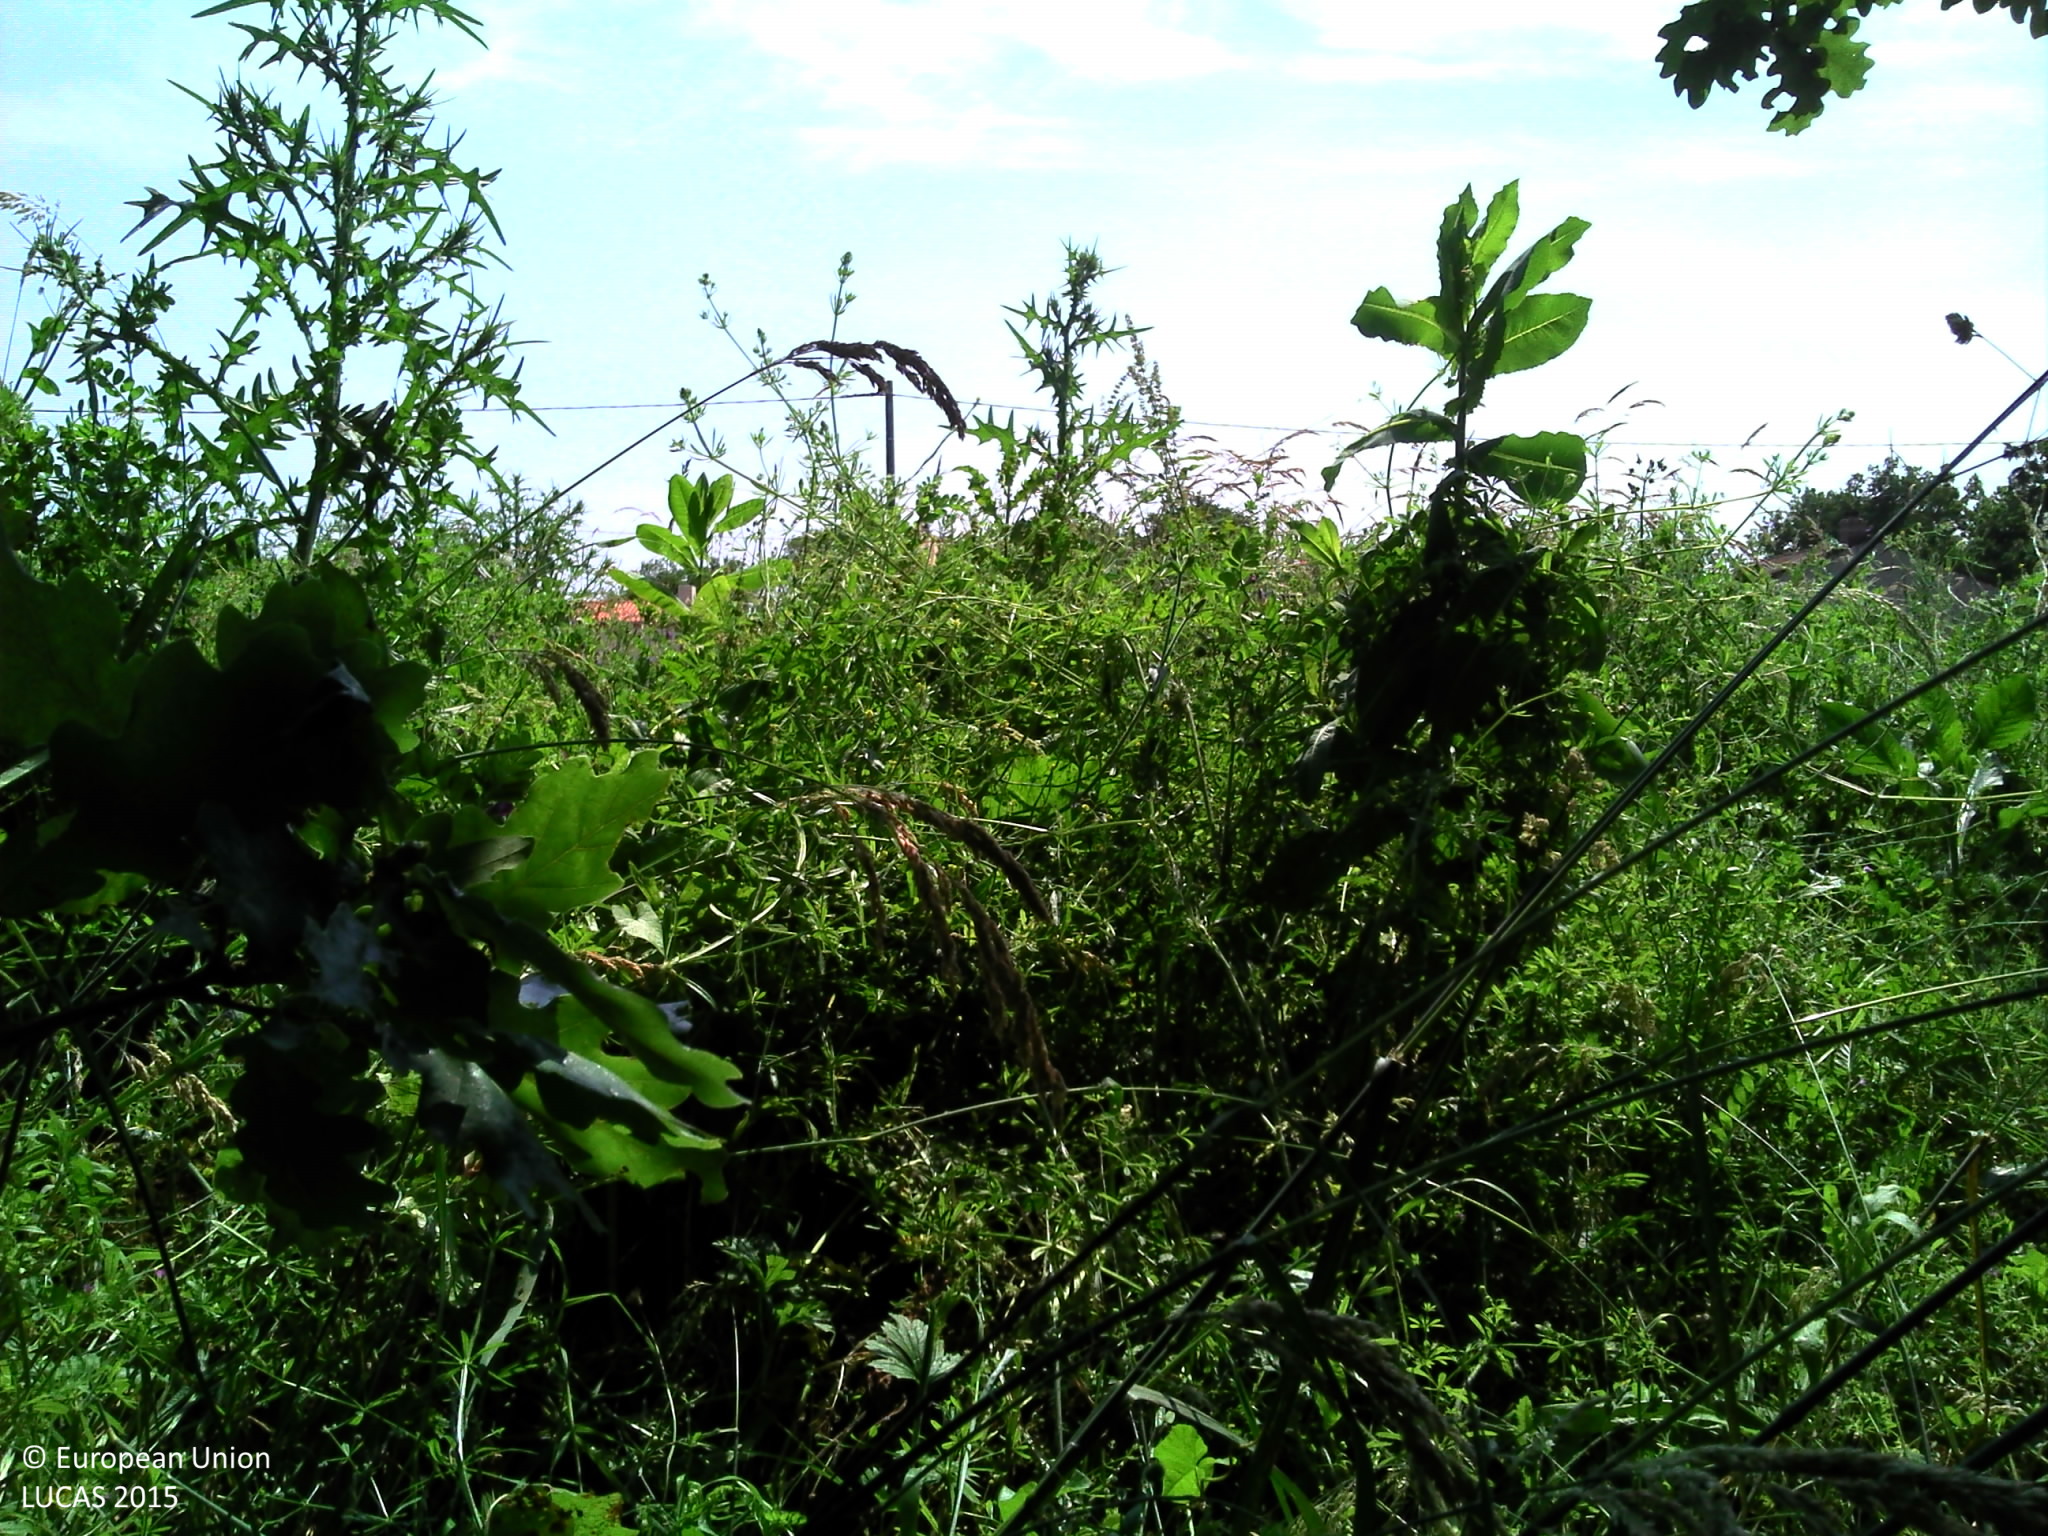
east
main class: Woodland
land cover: Broadleaved woodland
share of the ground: > 75 %
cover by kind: broadleaved forest trees 95 %, shrubs 5 %
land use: Semi-natural and natural areas not in use
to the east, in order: Broadleaved woodland; Spontaneously vegetated surfaces; Electric lines; Ditches and canals; Artificial constructions in urban areas; Broadleaved woodland; Fences; Grassland without tree/shrub cover; Spontaneously vegetated surfaces; Single bushes/trees; Spontaneously vegetated surfaces; Inland fresh water bodies; Grassland without tree/shrub cover
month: June
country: FR
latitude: 47.1468
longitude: -1.5008
